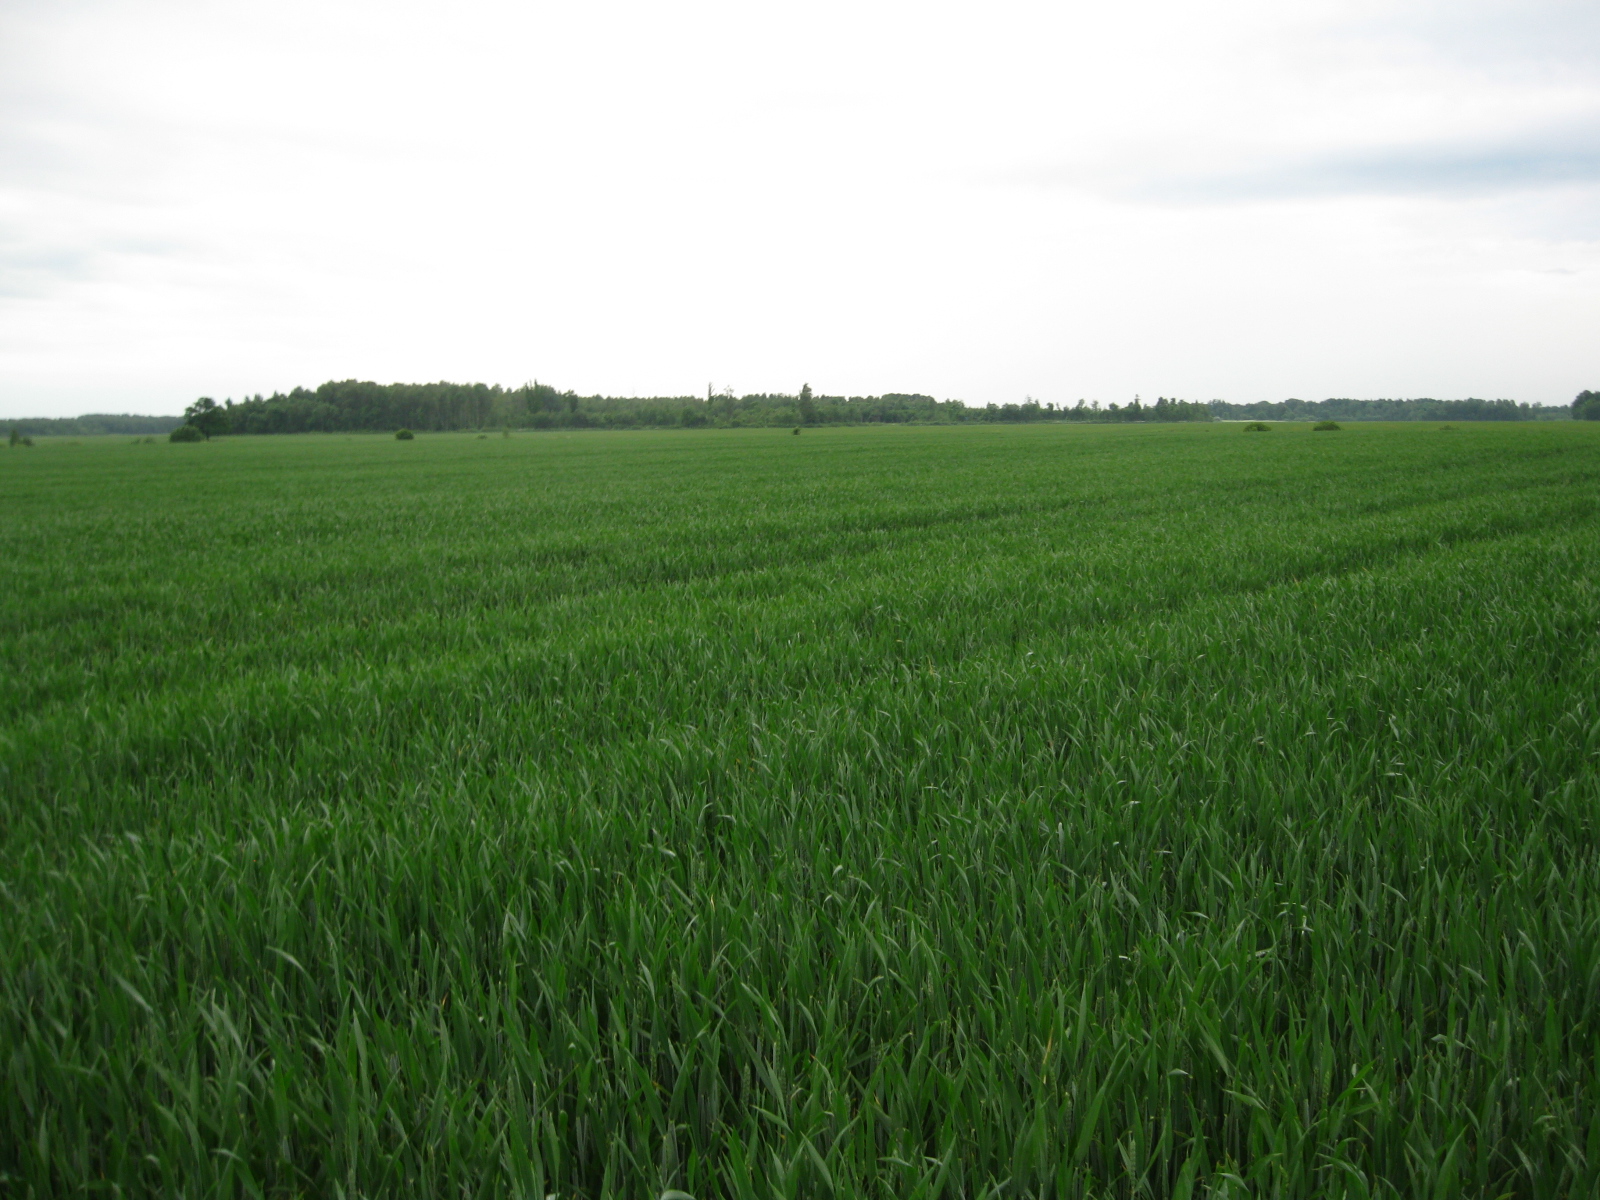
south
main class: Cropland
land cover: Common wheat
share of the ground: > 75 %
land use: Agriculture (excluding fallow land and kitchen gardens)
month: June
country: LT
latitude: 55.6461
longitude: 23.8945
